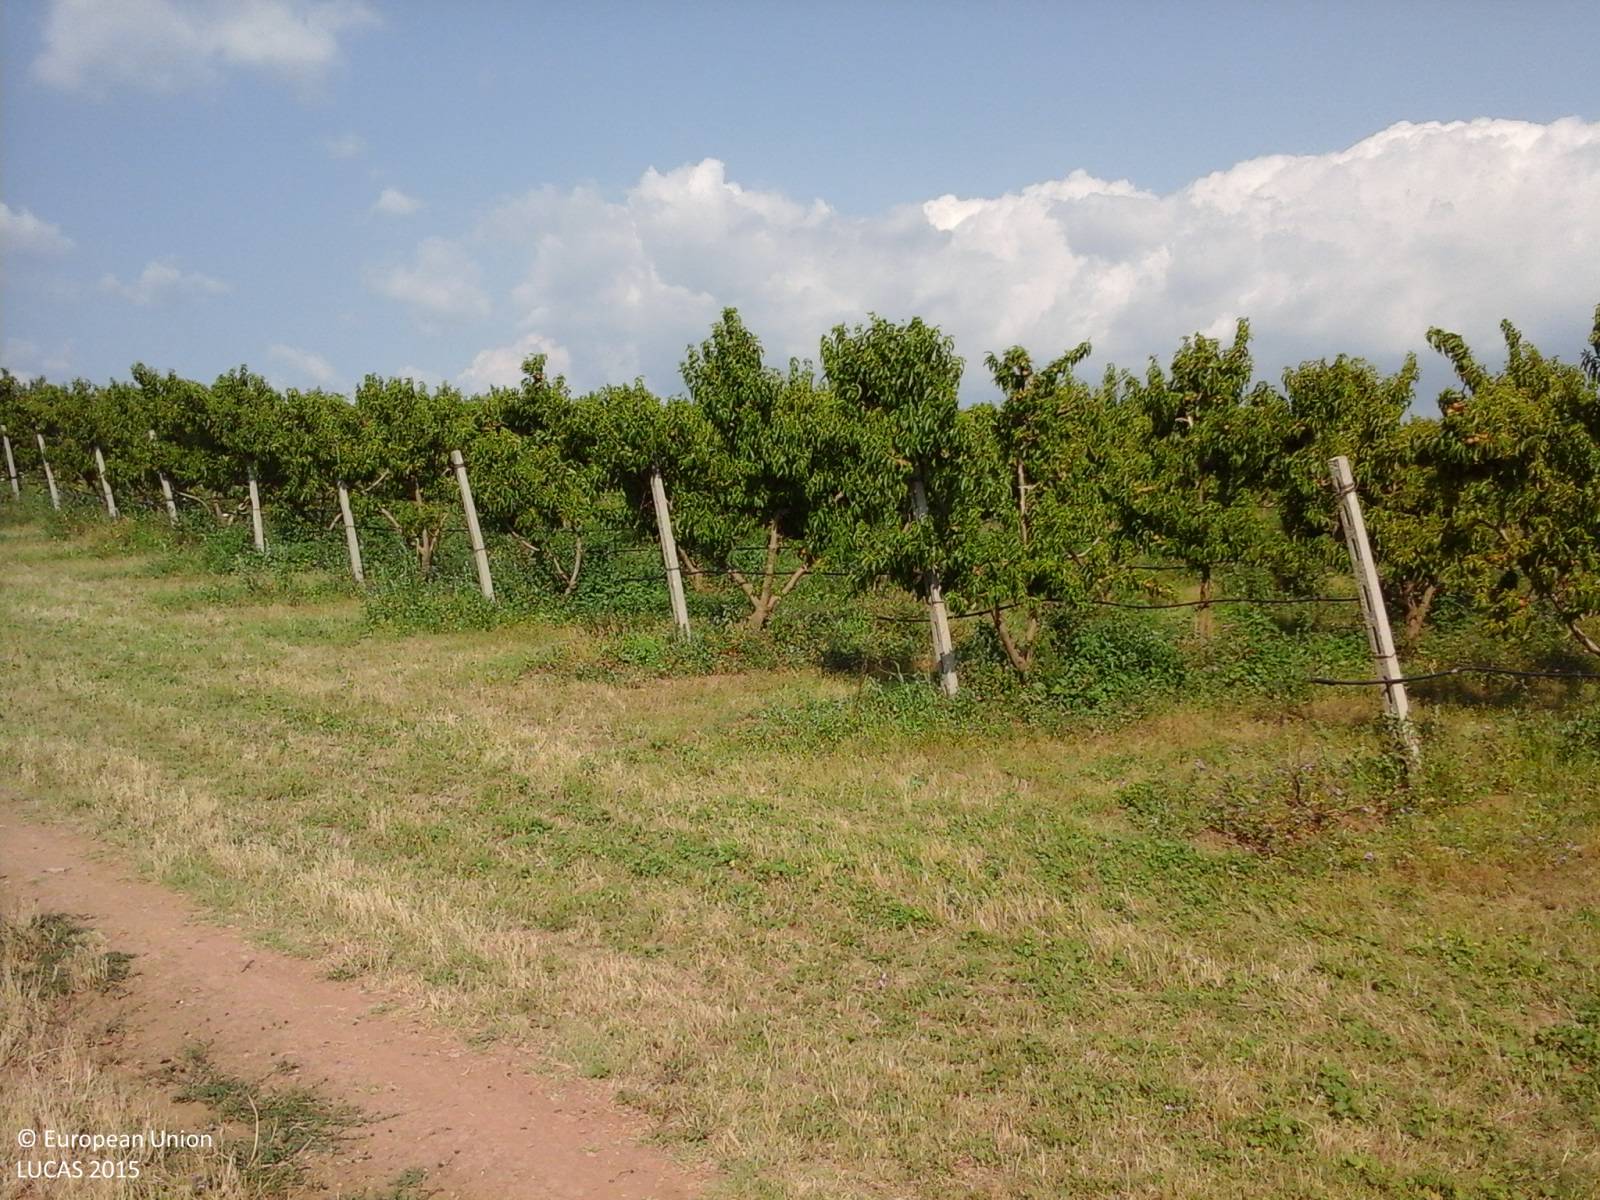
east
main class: Cropland
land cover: Other fruit trees and berries
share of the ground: > 75 %
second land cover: Spontaneously vegetated surfaces
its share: 50 - 75 %
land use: Agriculture (excluding fallow land and kitchen gardens)
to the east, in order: Other fruit trees and berries; Spontaneously vegetated surfaces; Fences; Grassland without tree/shrub cover; Fences; Tracks; Grassland without tree/shrub cover; Other fruit trees and berries; Tracks; Other fruit trees and berries
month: July
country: IT
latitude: 41.9117
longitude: 12.7507
